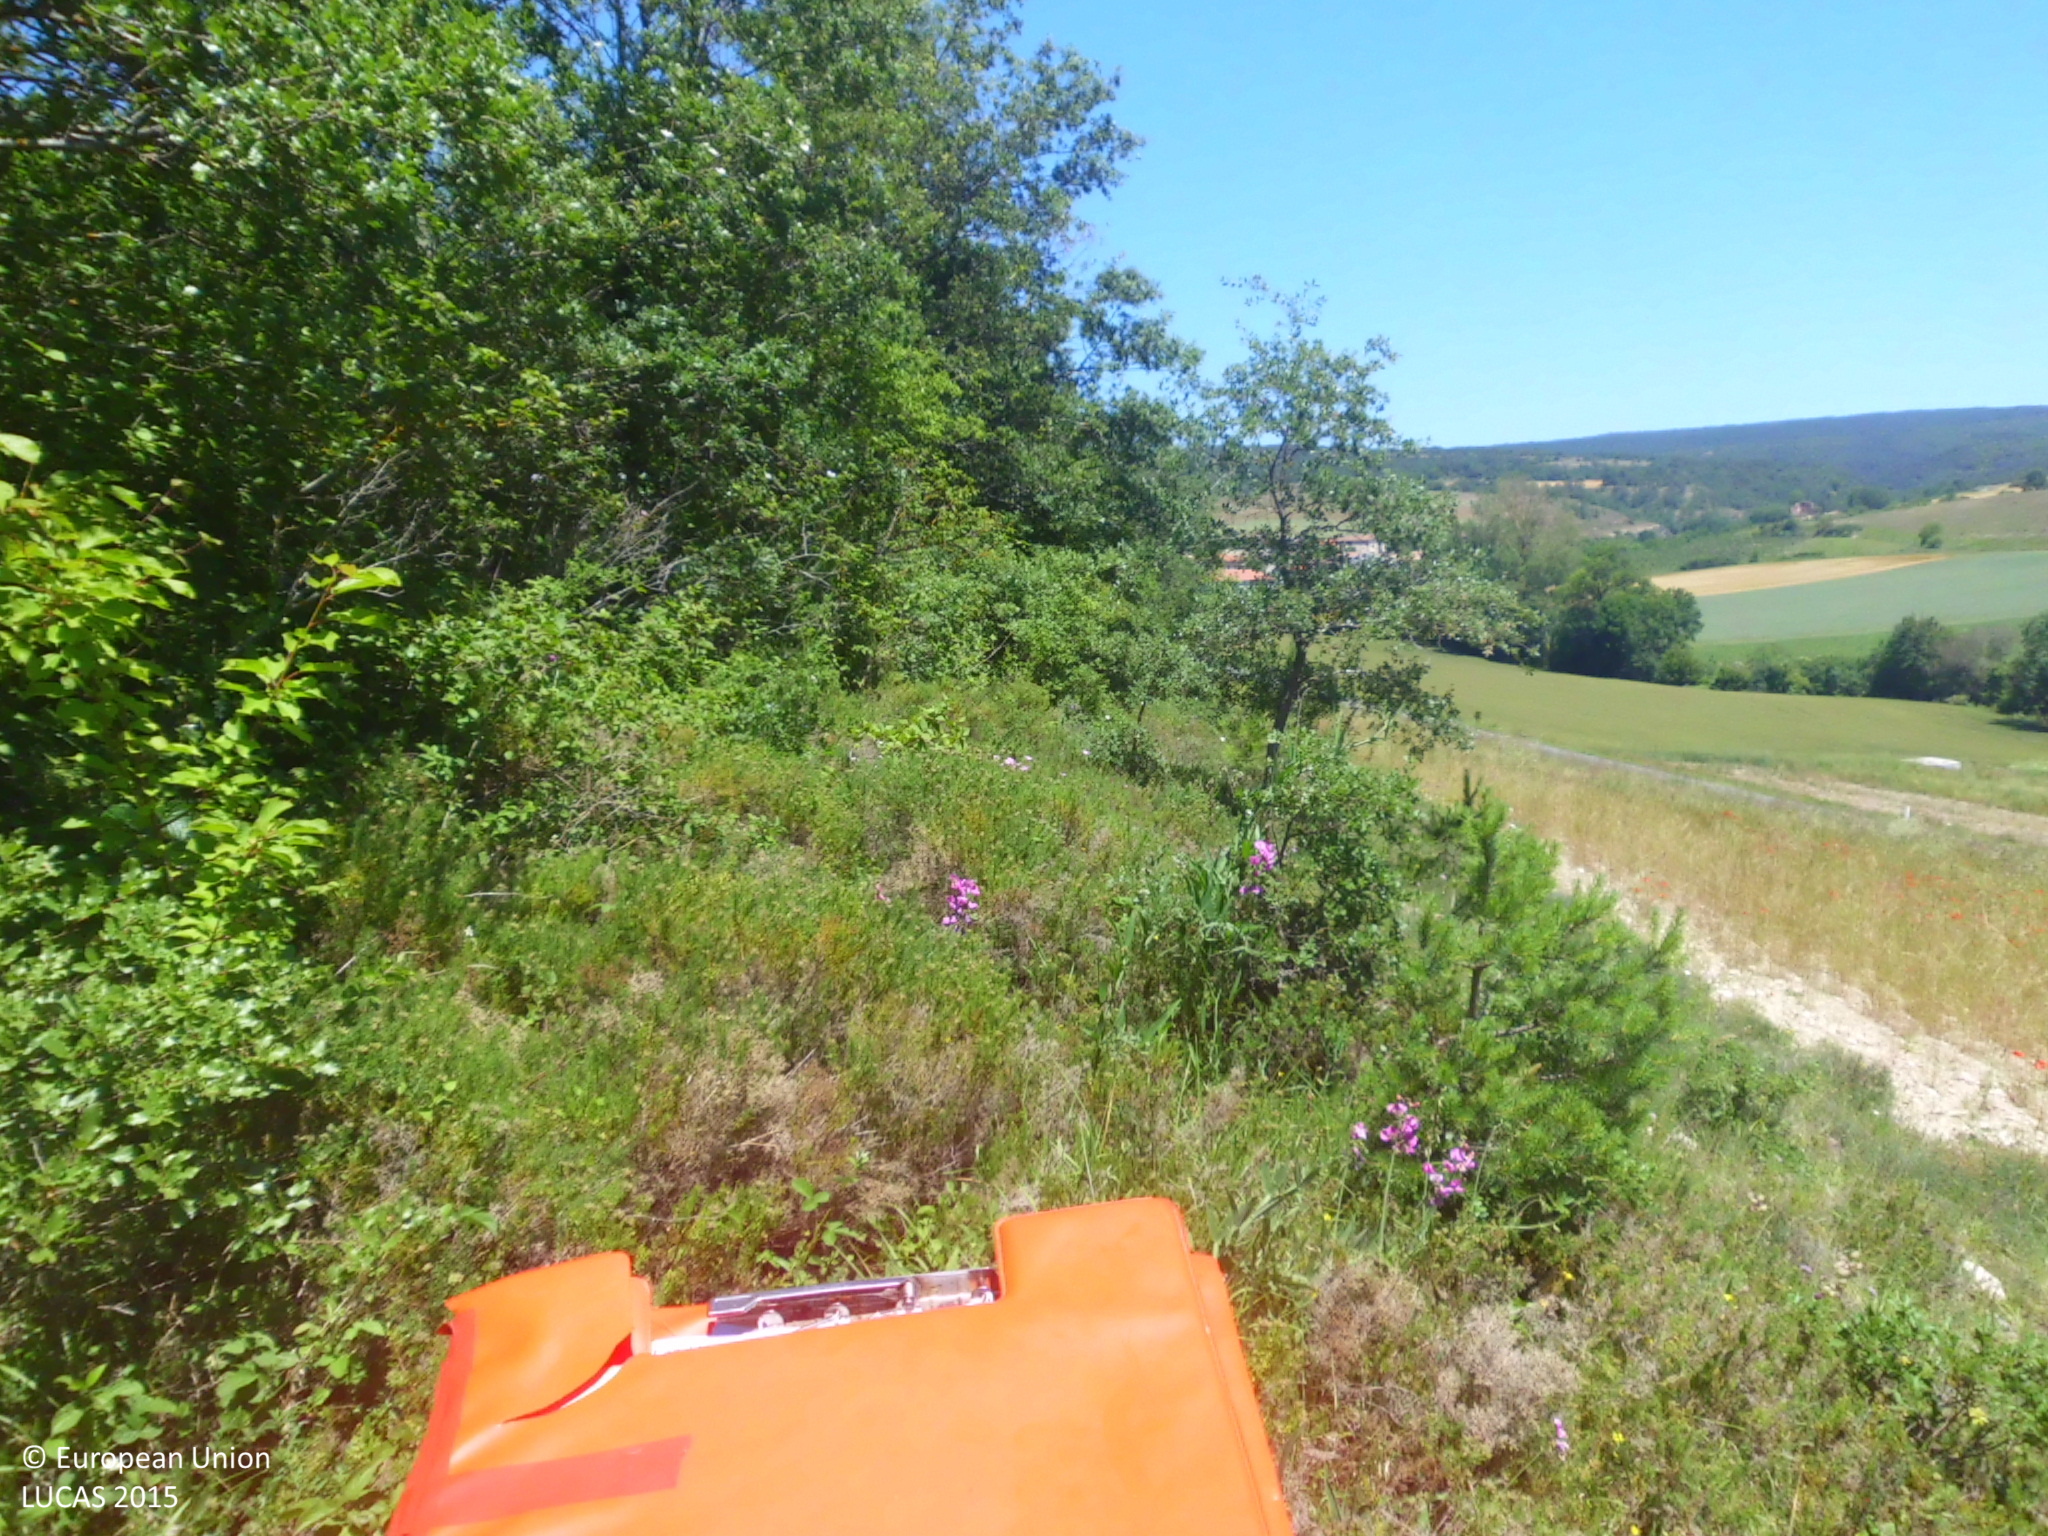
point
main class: Woodland
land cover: Broadleaved woodland
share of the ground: 25 - 50 %
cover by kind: herbaceous plants 50 %, broadleaved forest trees 35 %, shrubs 15 %
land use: Semi-natural and natural areas not in use
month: June
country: ES
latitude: 42.8890
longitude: -3.1477
